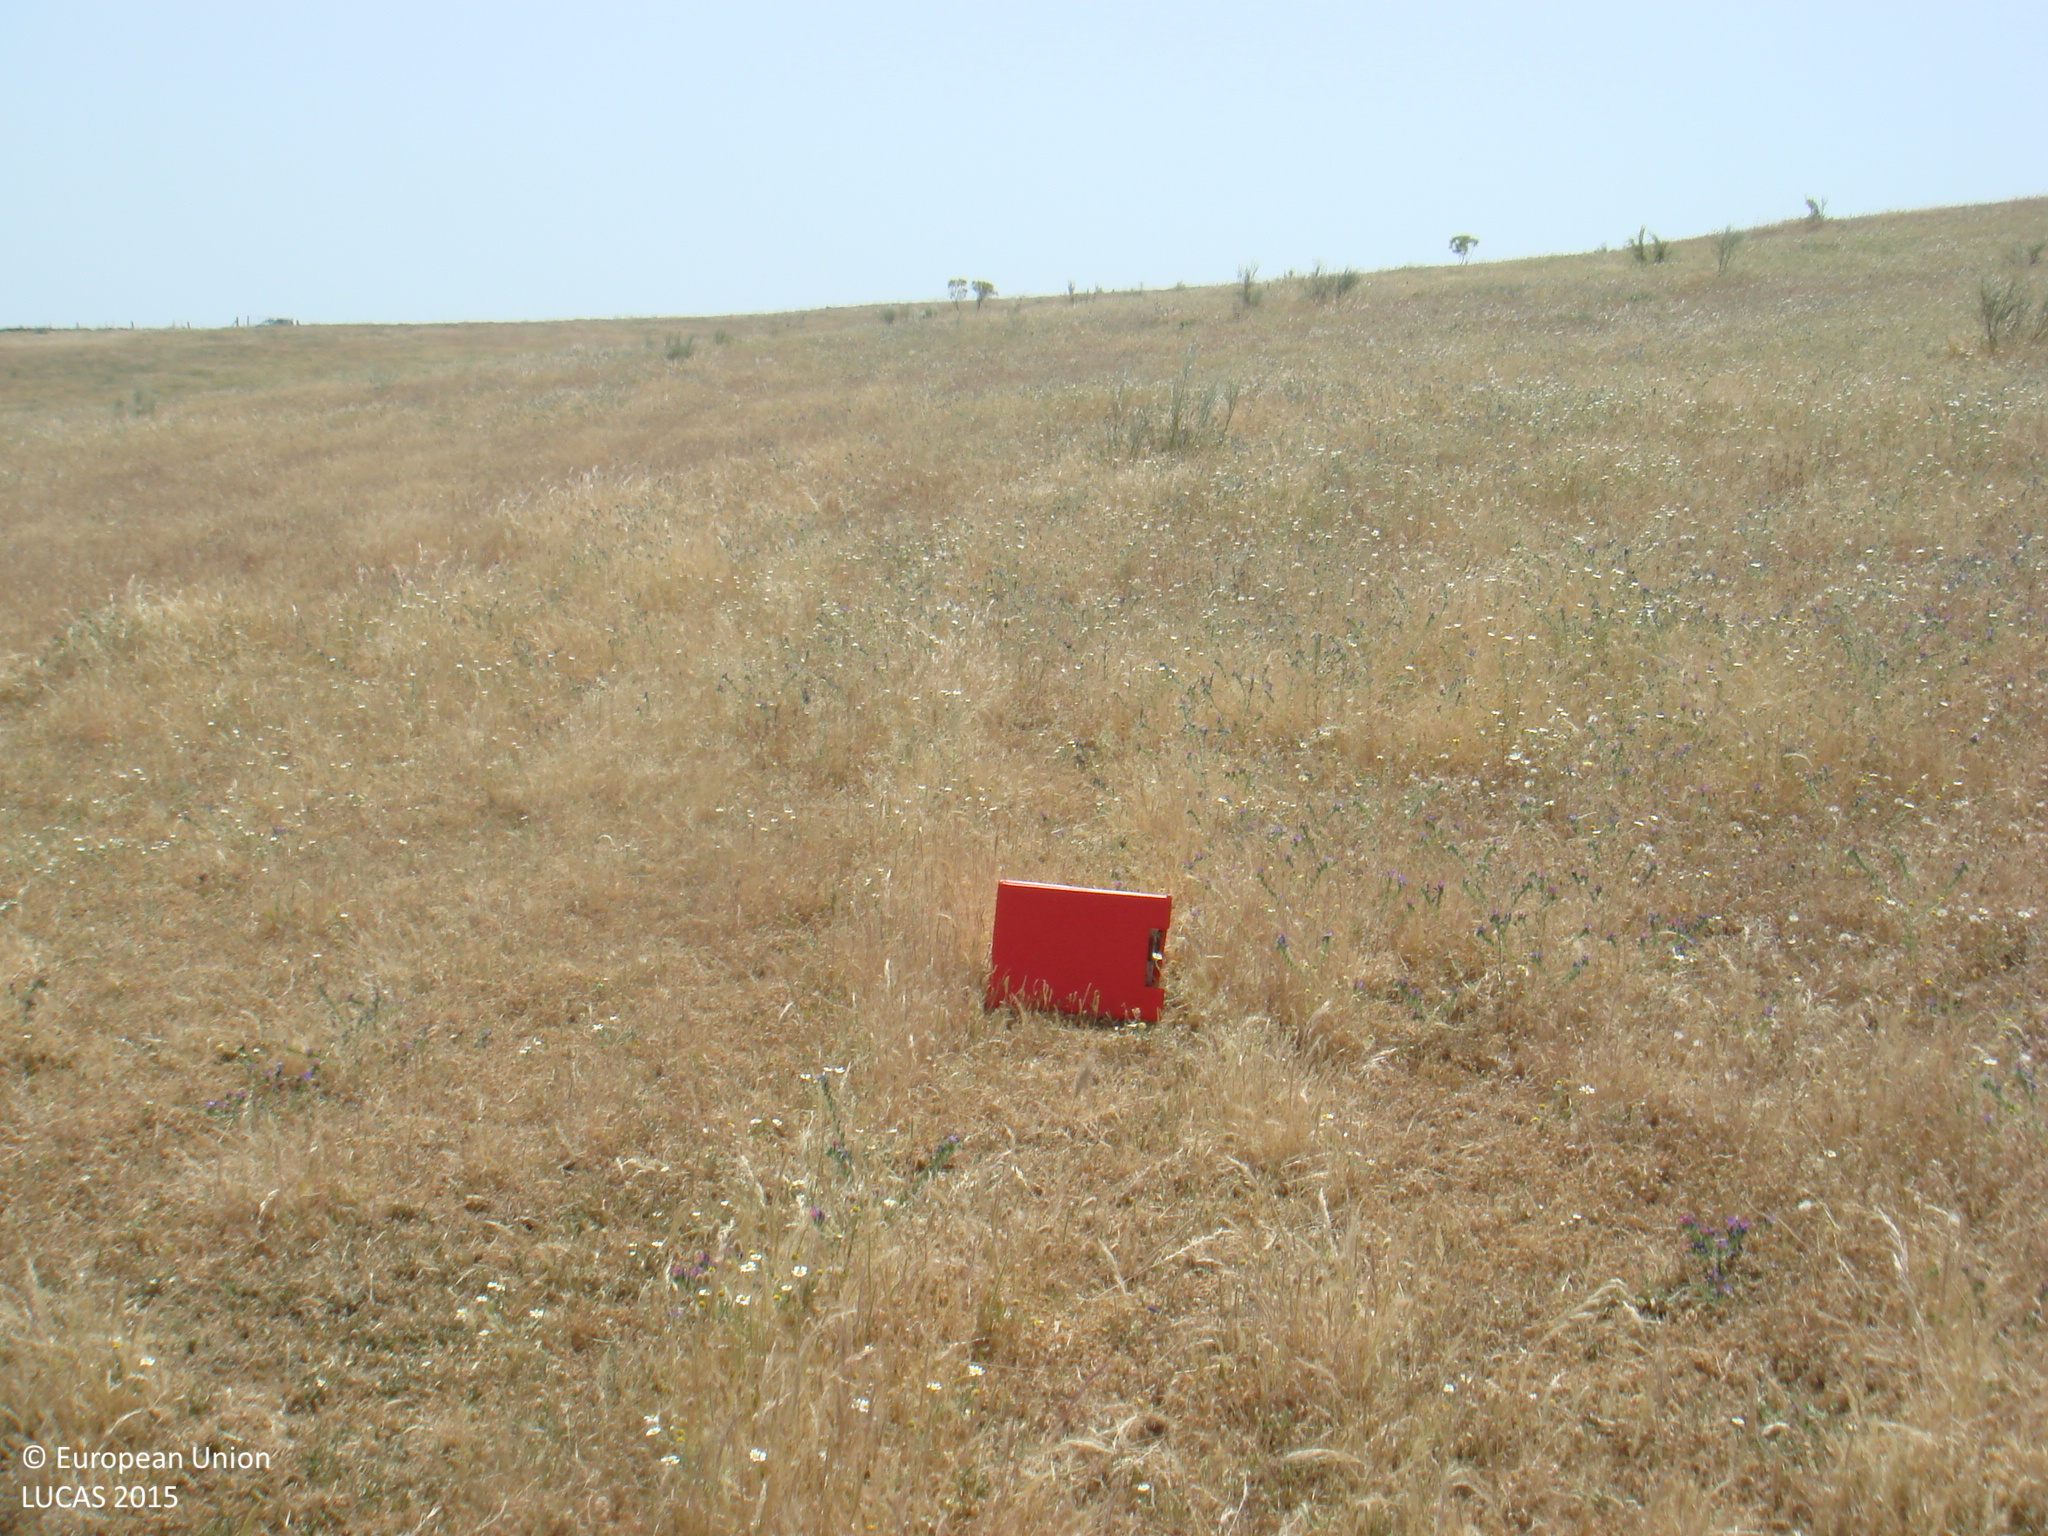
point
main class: Grassland
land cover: Grassland without tree/shrub cover
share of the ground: > 75 %
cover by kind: herbaceous plants 100 %
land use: Agriculture (excluding fallow land and kitchen gardens)
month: May
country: ES
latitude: 38.4941
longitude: -4.6873
